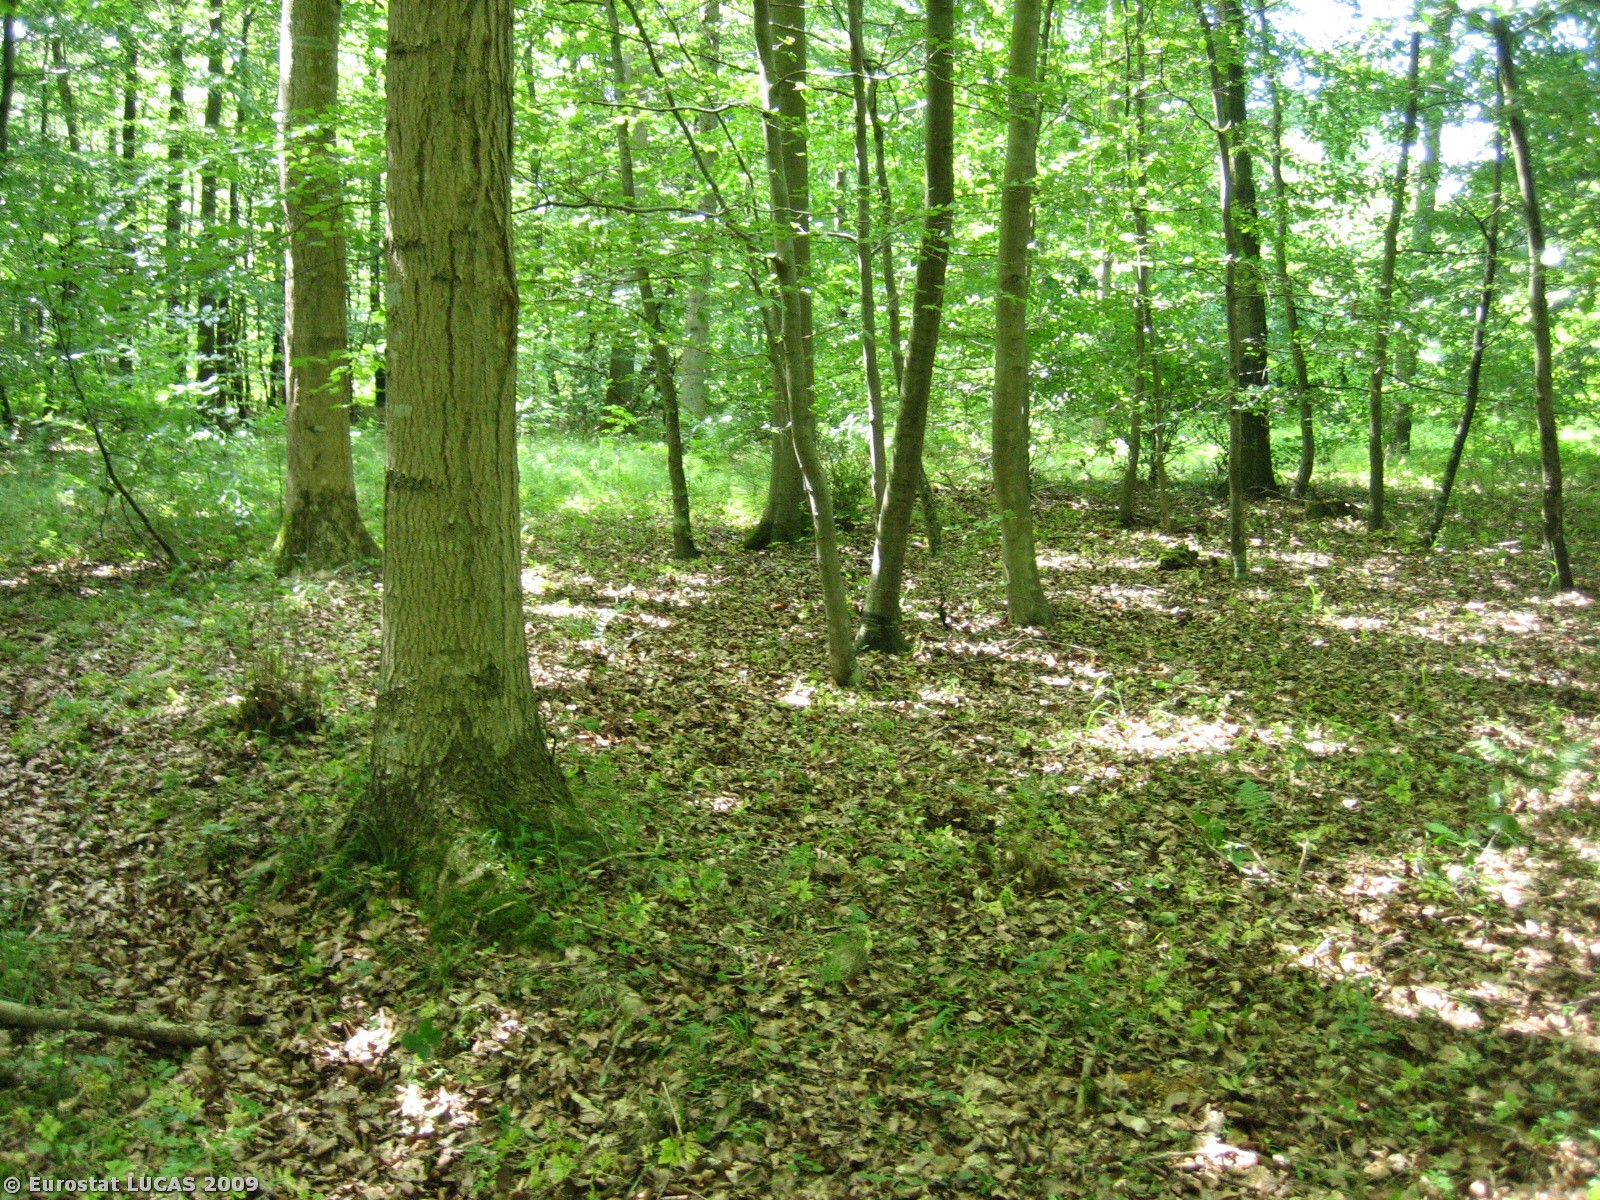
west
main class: Woodland
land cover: Broadleaved woodland
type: mesophytic deciduous forest
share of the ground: > 75 %
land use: Forestry
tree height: > 5 m
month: June
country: DK
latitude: 55.6844
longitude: 9.8570
